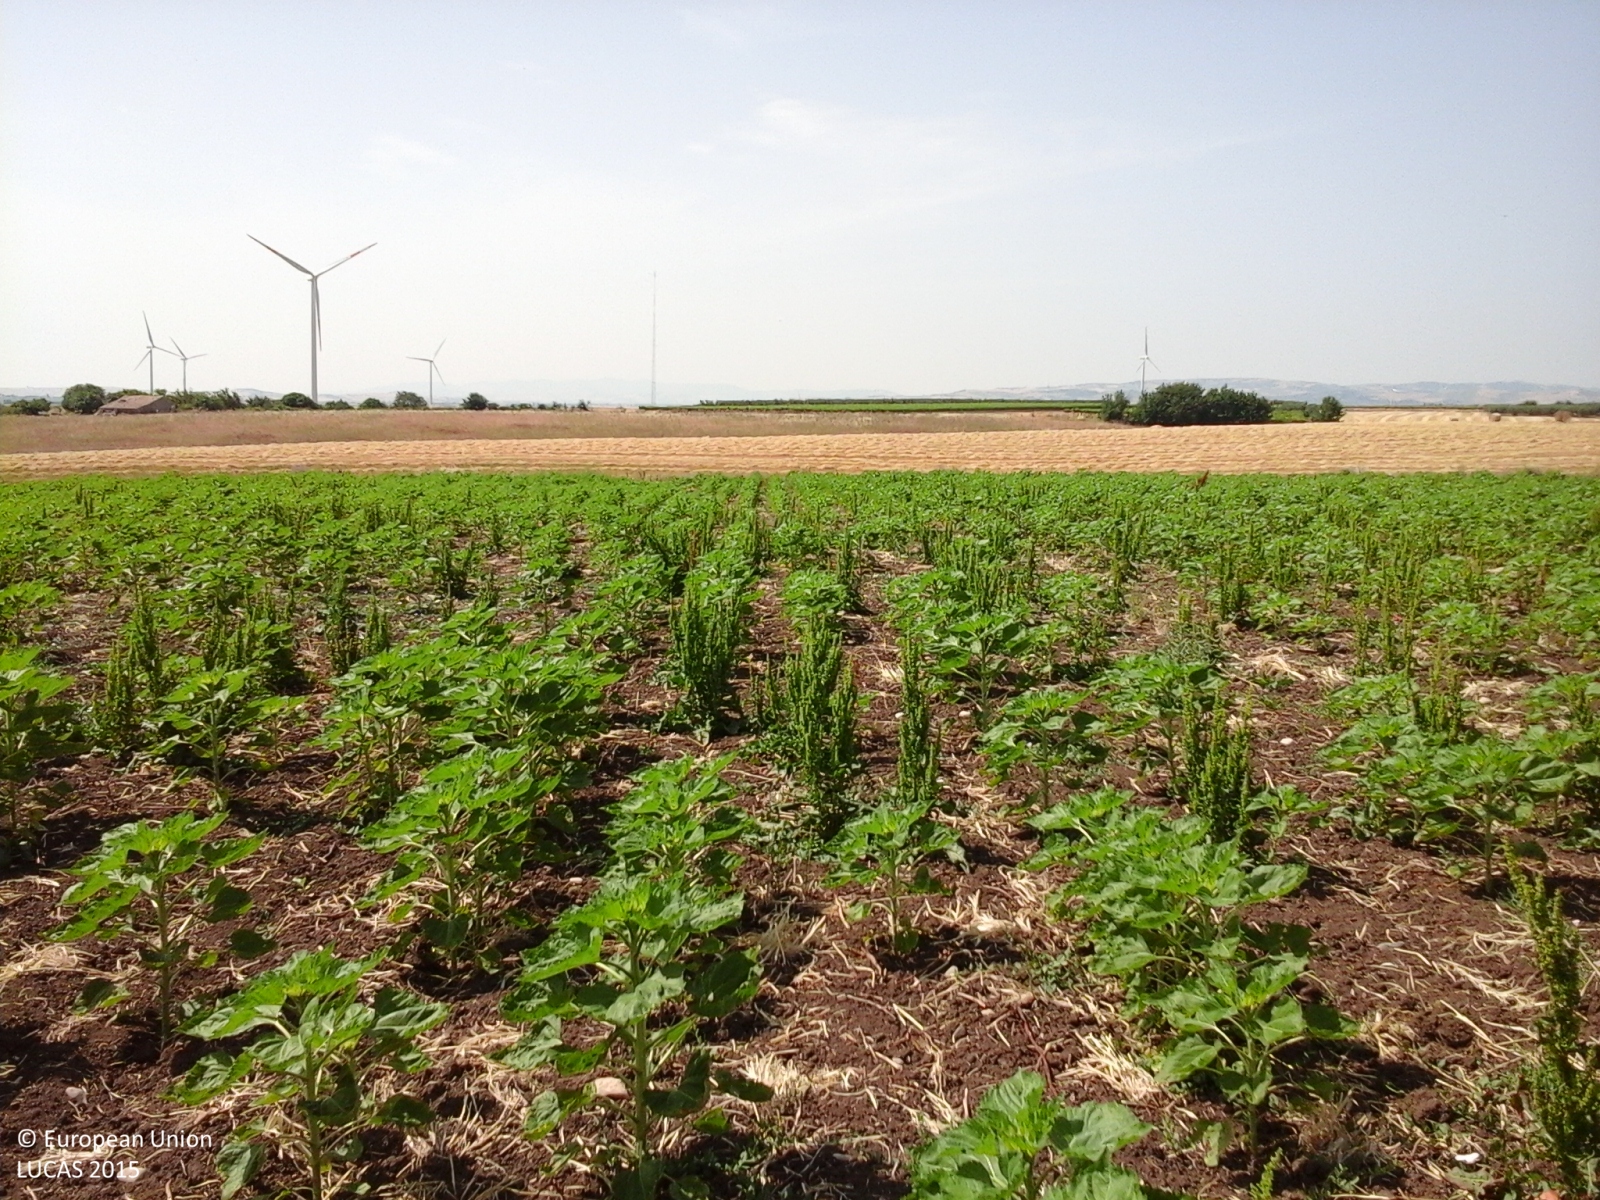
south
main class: Cropland
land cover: Sunflower
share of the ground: > 75 %
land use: Agriculture (excluding fallow land and kitchen gardens)
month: June
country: IT
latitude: 41.8582
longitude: 15.0556
